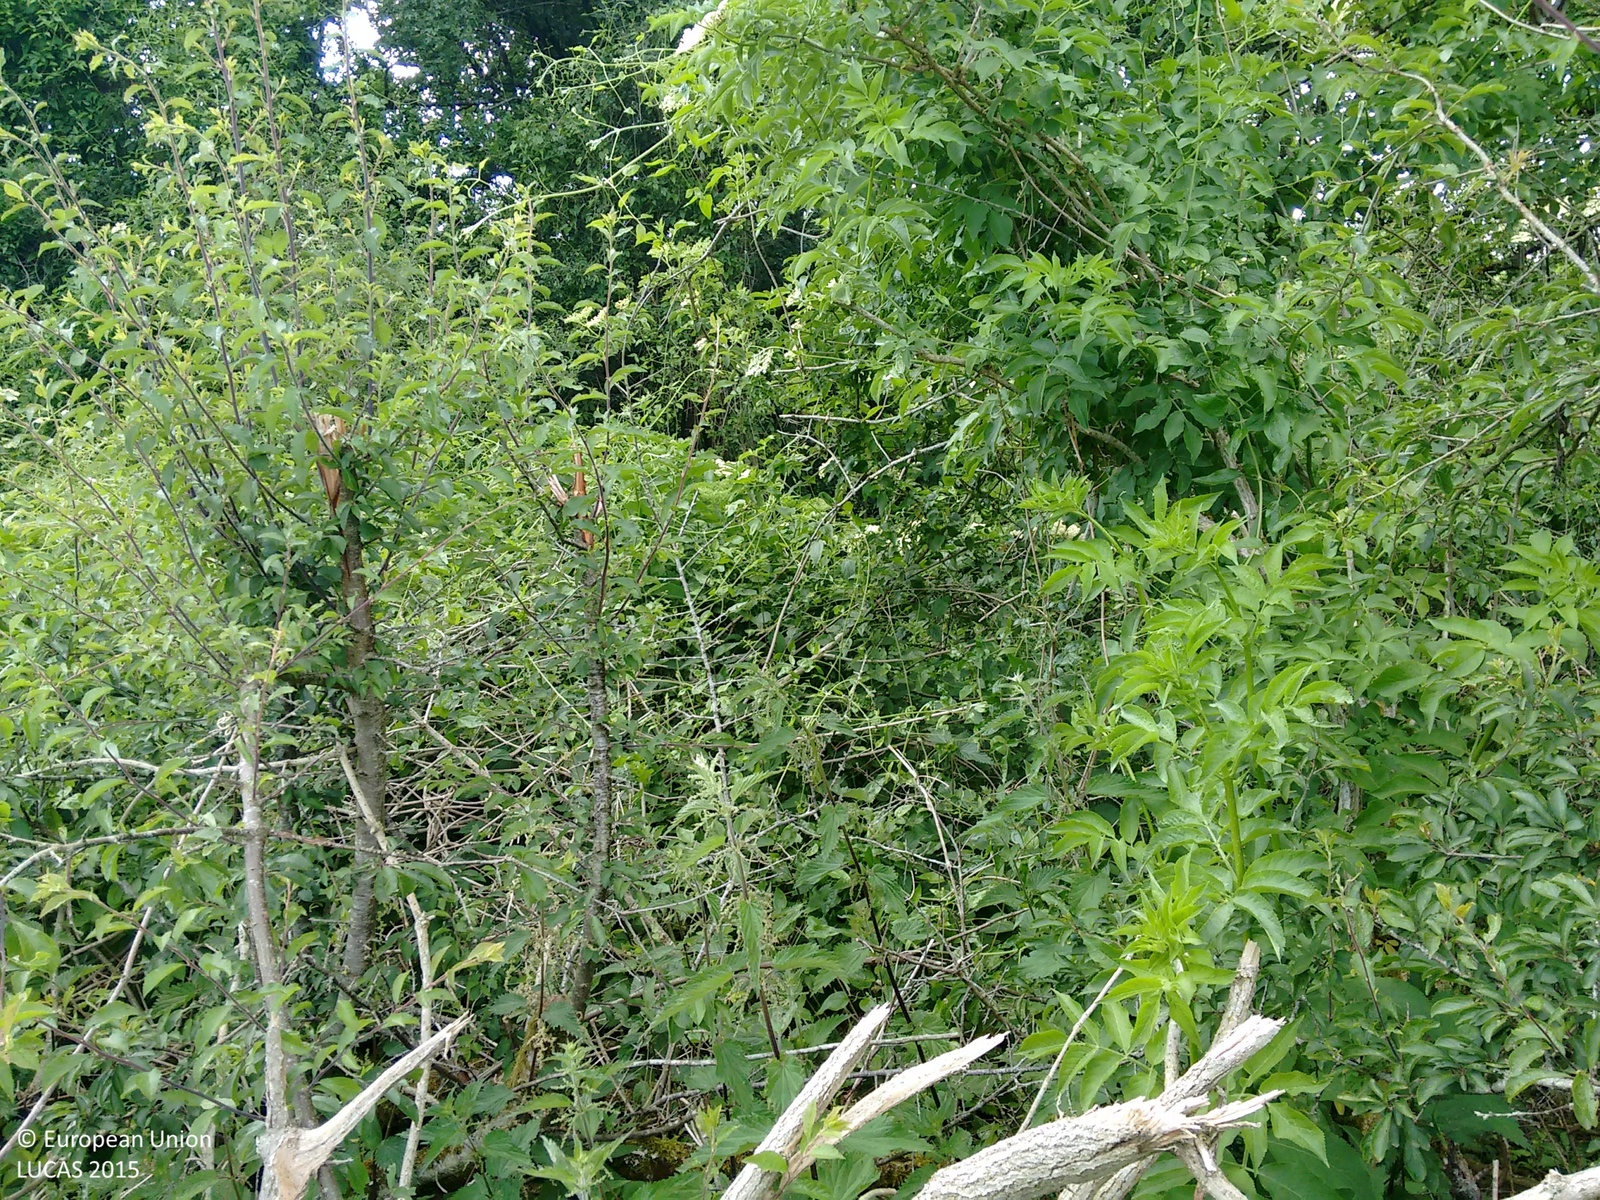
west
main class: Woodland
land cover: Broadleaved woodland
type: mesophytic deciduous forest
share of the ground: > 75 %
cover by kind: broadleaved forest trees 100 %
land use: Agriculture (excluding fallow land and kitchen gardens)
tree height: > 5 m
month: June
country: GB
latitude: 51.3485
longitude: -2.3397
